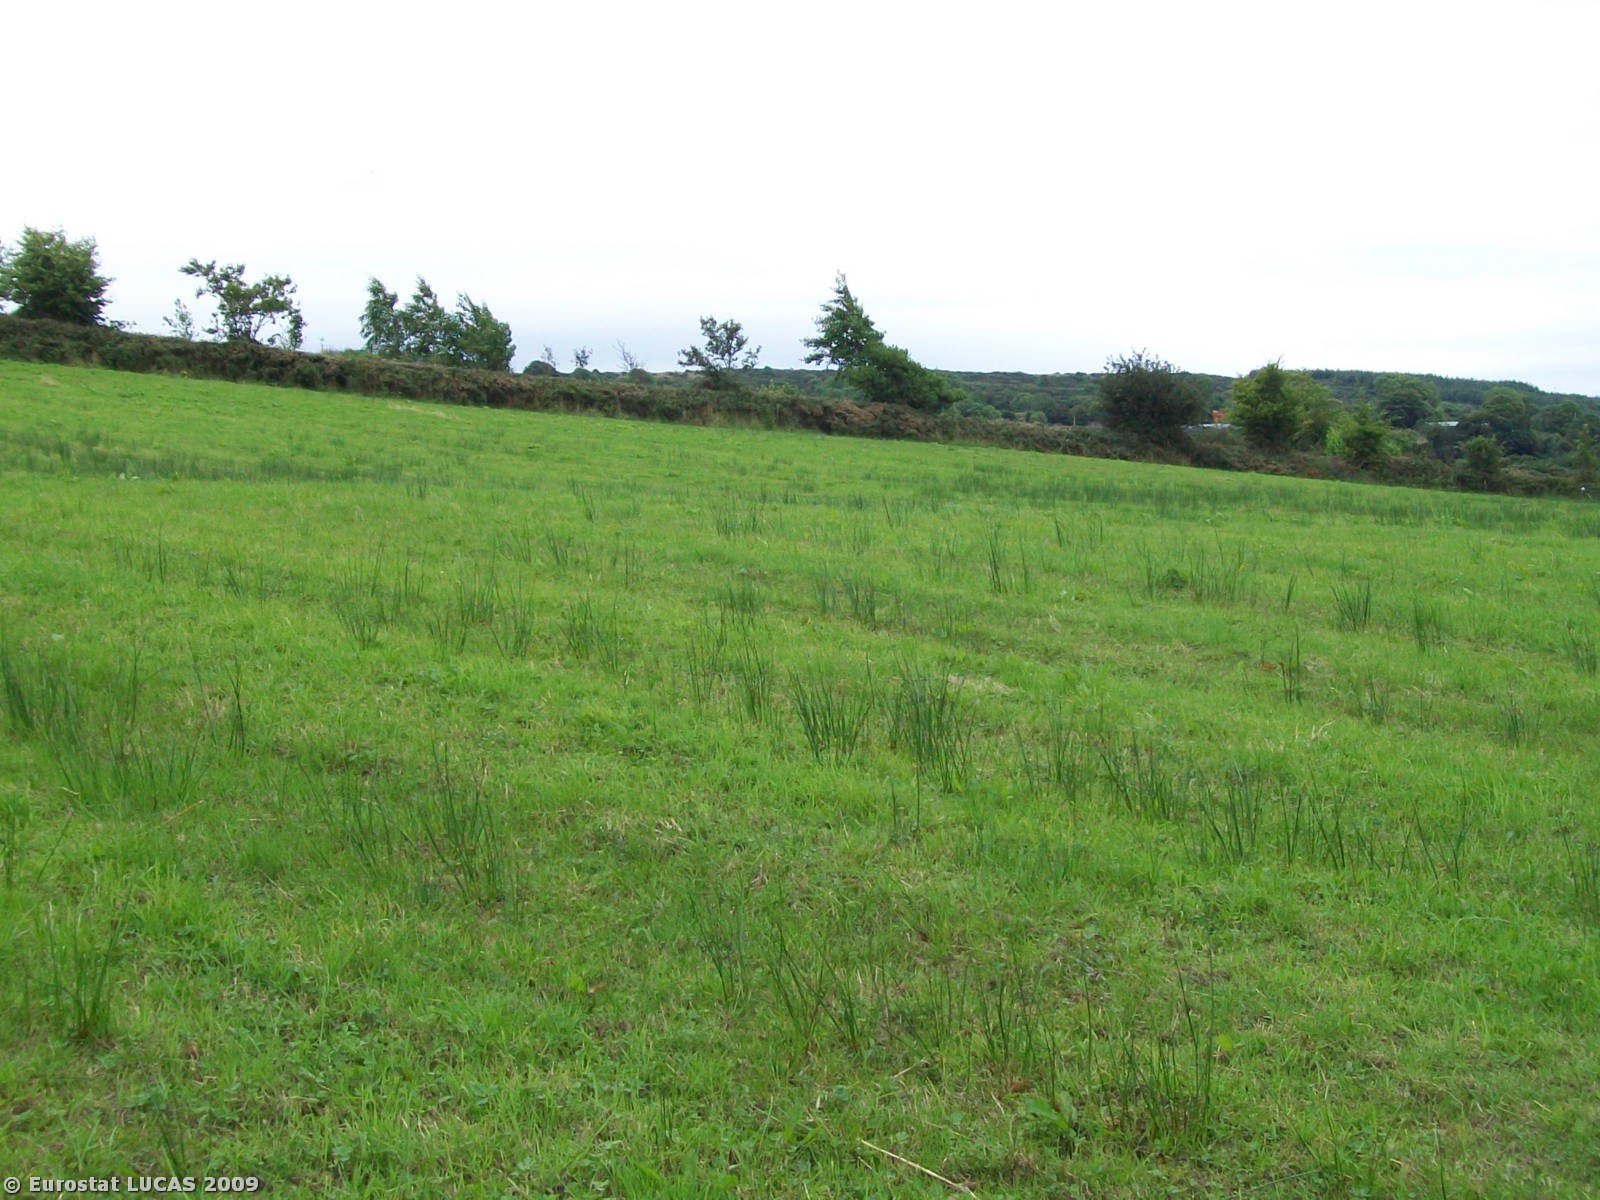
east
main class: Grassland
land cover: Grassland without tree/shrub cover
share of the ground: > 75 %
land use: Agriculture (excluding fallow land and kitchen gardens)
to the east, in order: Grassland without tree/shrub cover; Managed hedges; Grass margins; Tracks; Broadleaved woodland; Tracks; Grassland without tree/shrub cover; Broadleaved woodland; Grassland without tree/shrub cover; Fences; Grass margins; Inland running water; Grassland without tree/shrub cover
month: August
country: GB
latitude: 54.1271
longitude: -6.5461
